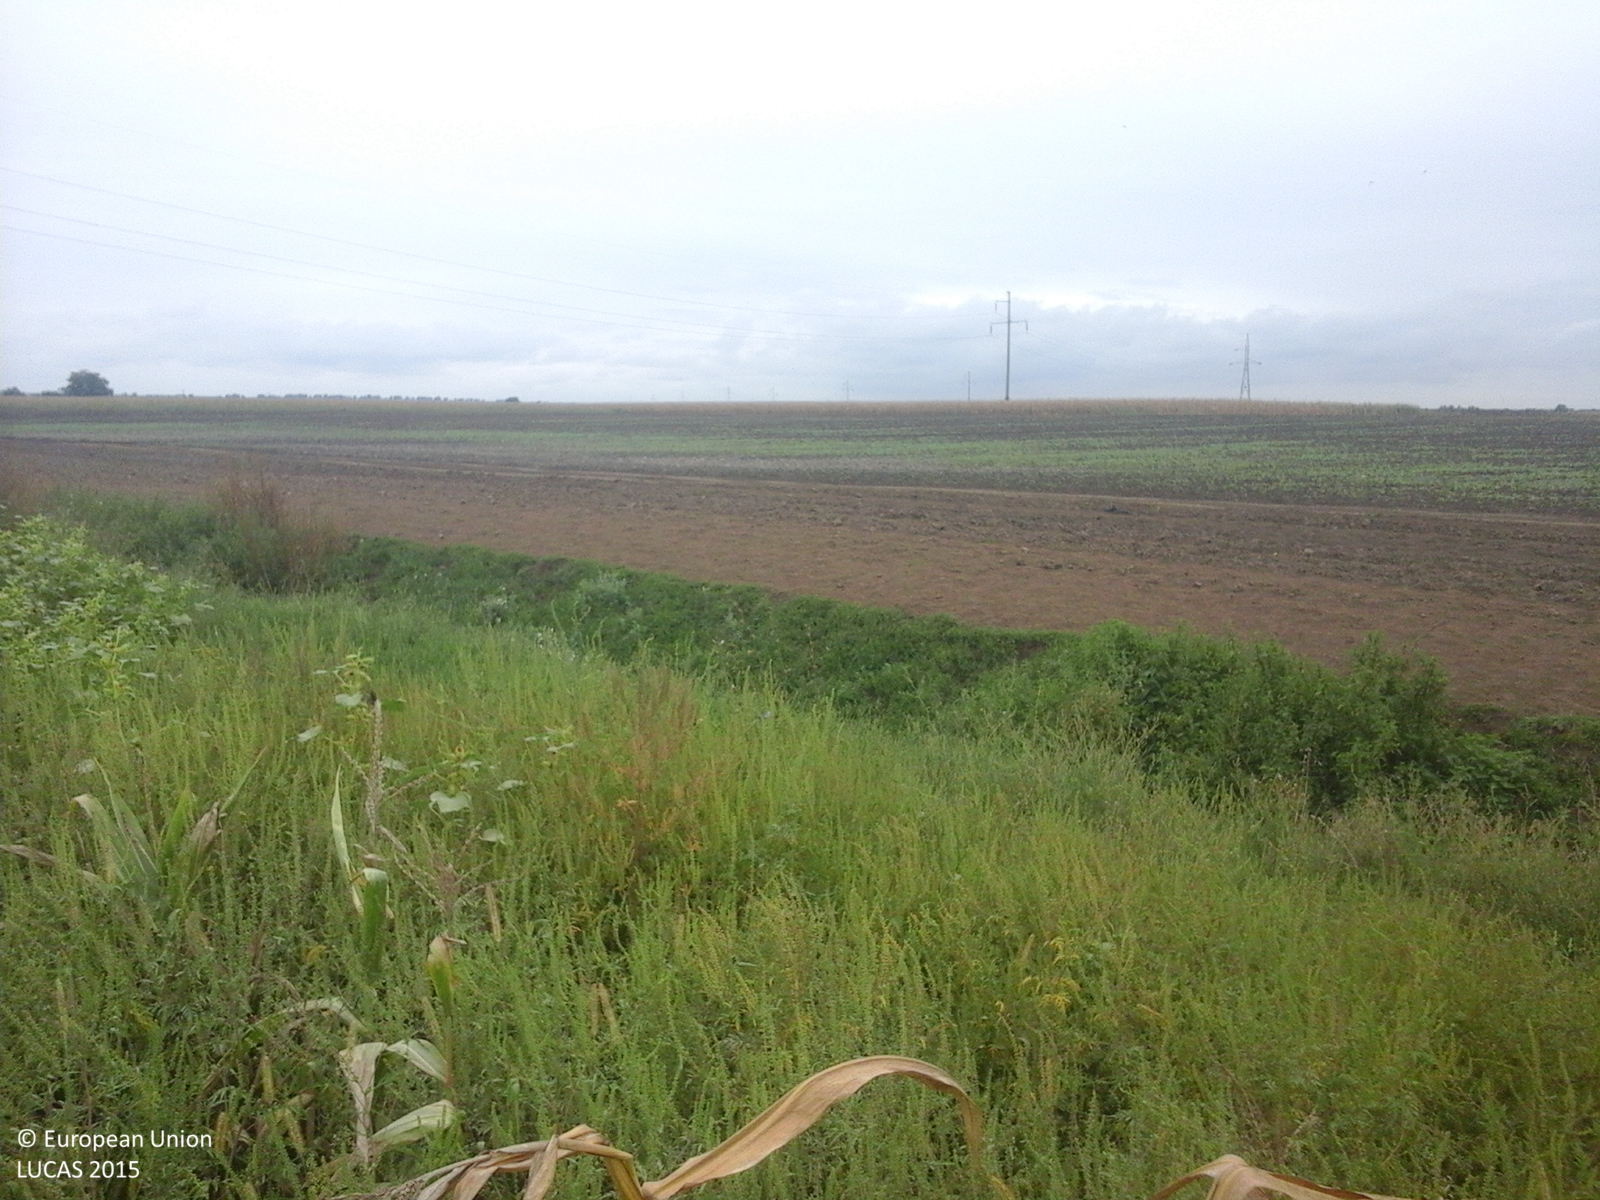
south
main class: Cropland
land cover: Maize
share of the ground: > 75 %
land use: Agriculture (excluding fallow land and kitchen gardens)
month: September
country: RO
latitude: 47.3143
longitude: 21.9673
